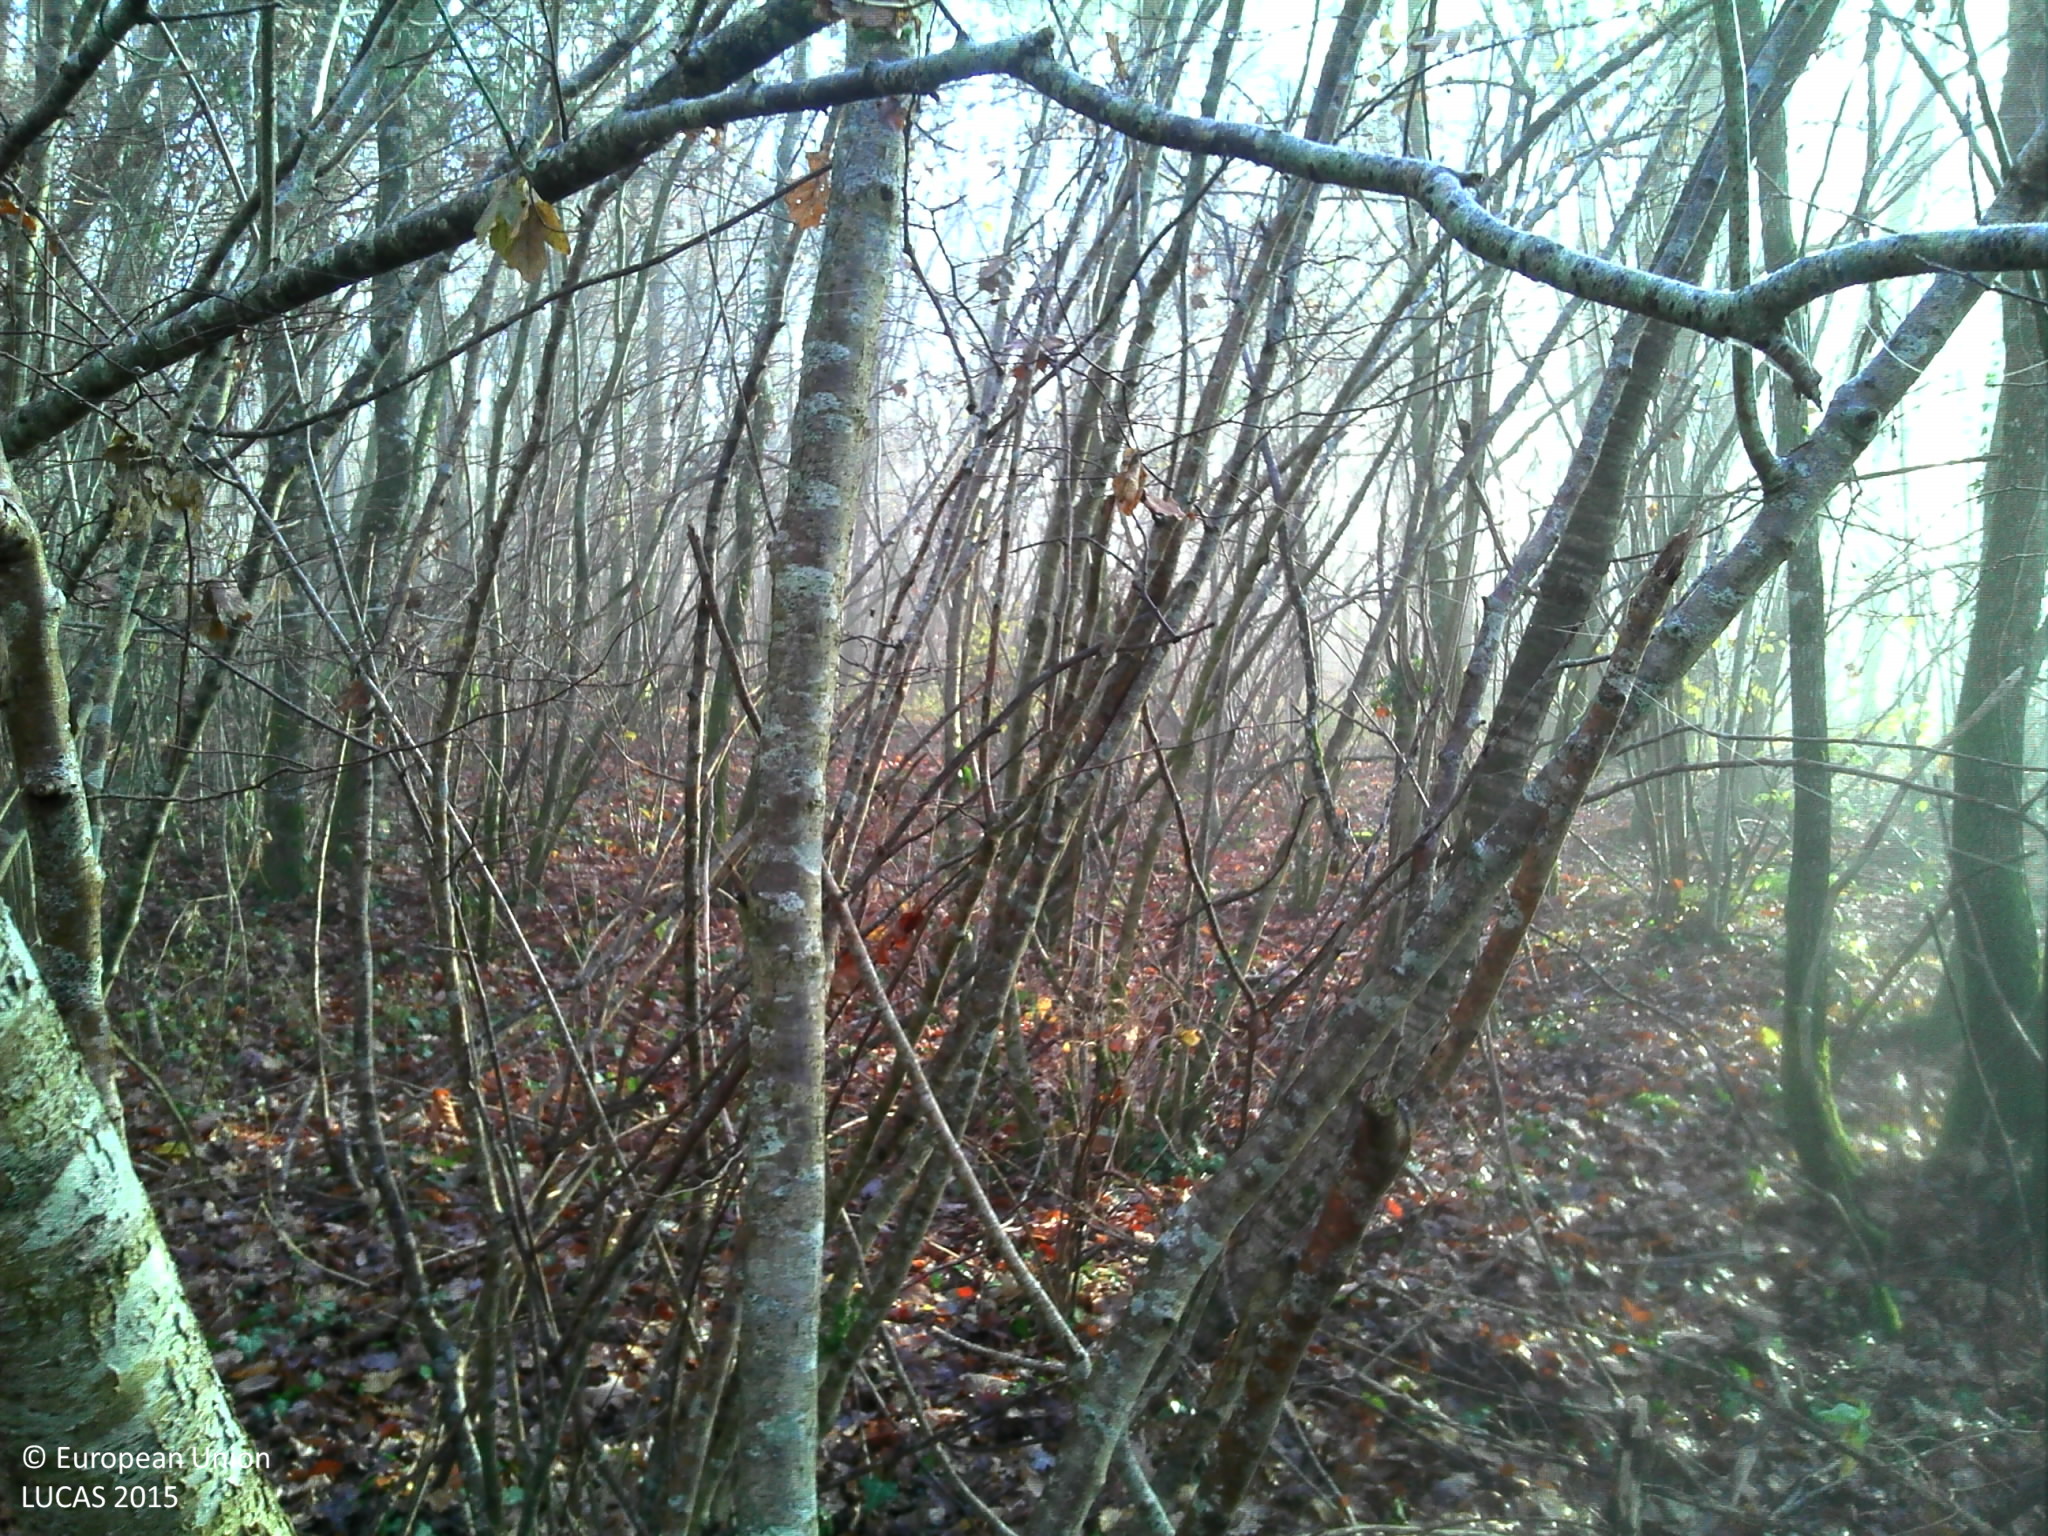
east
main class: Woodland
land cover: Broadleaved woodland
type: mesophytic deciduous forest
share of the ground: > 75 %
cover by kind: broadleaved forest trees 100 %
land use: Forestry
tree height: > 5 m
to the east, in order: Broadleaved woodland; Grassland without tree/shrub cover; Broadleaved woodland; Tracks; Broadleaved woodland
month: December
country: FR
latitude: 47.4514
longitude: 3.1646
